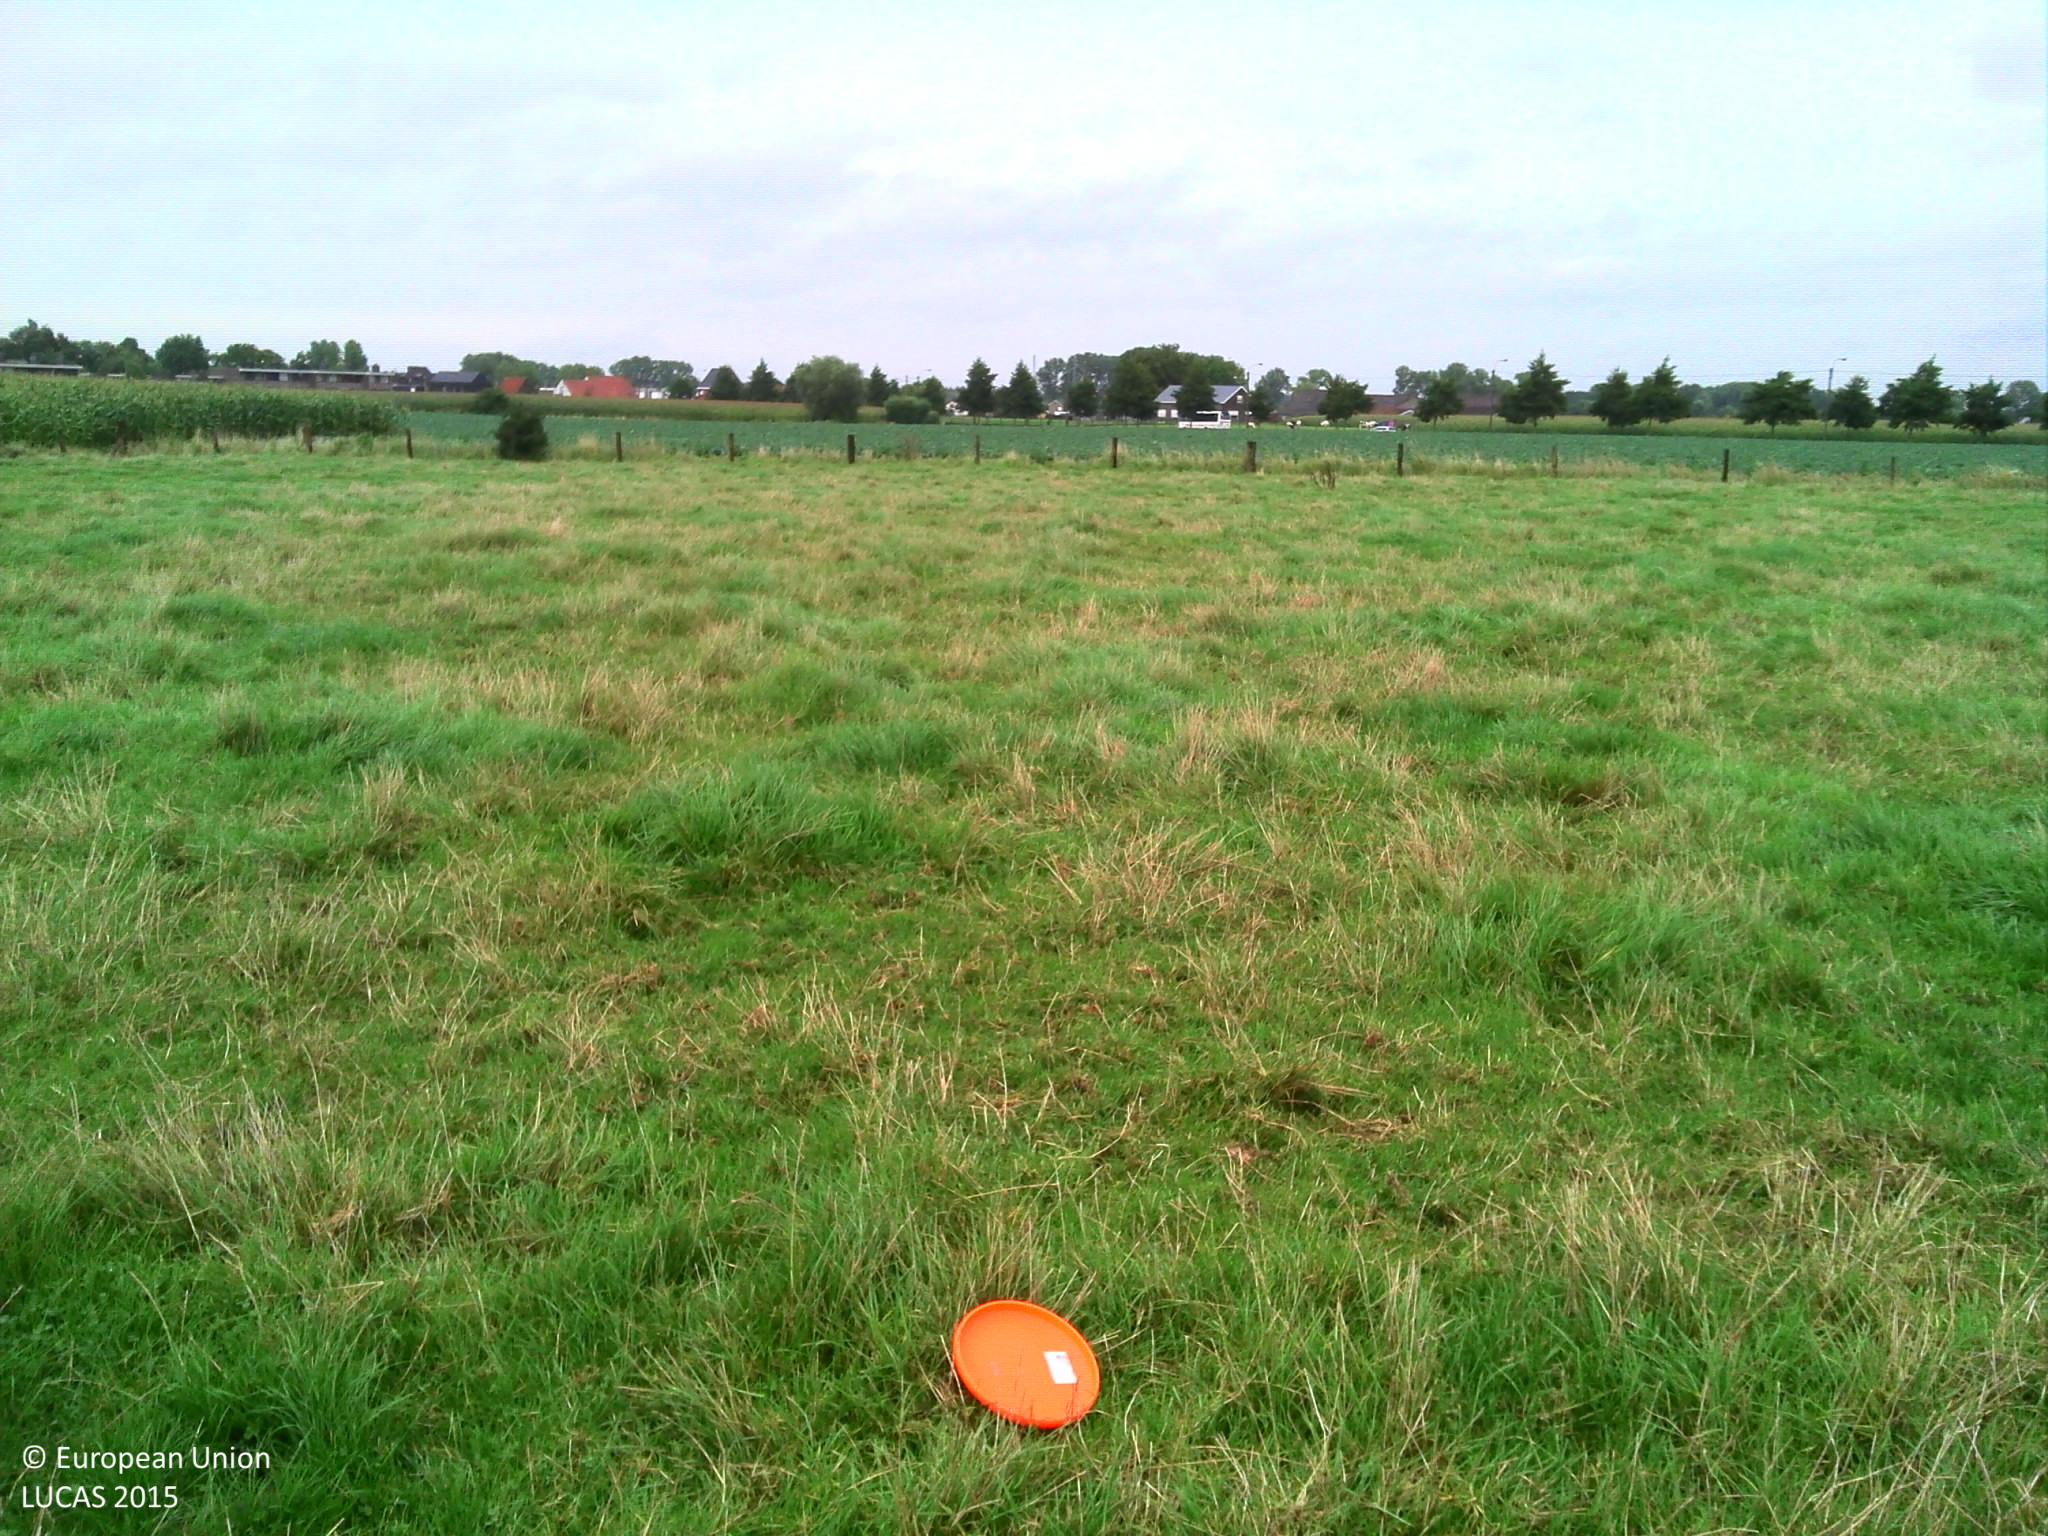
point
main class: Grassland
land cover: Grassland without tree/shrub cover
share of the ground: > 75 %
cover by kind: herbaceous plants 100 %
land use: Agriculture (excluding fallow land and kitchen gardens)
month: September
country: BE
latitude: 51.1328
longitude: 3.1454
